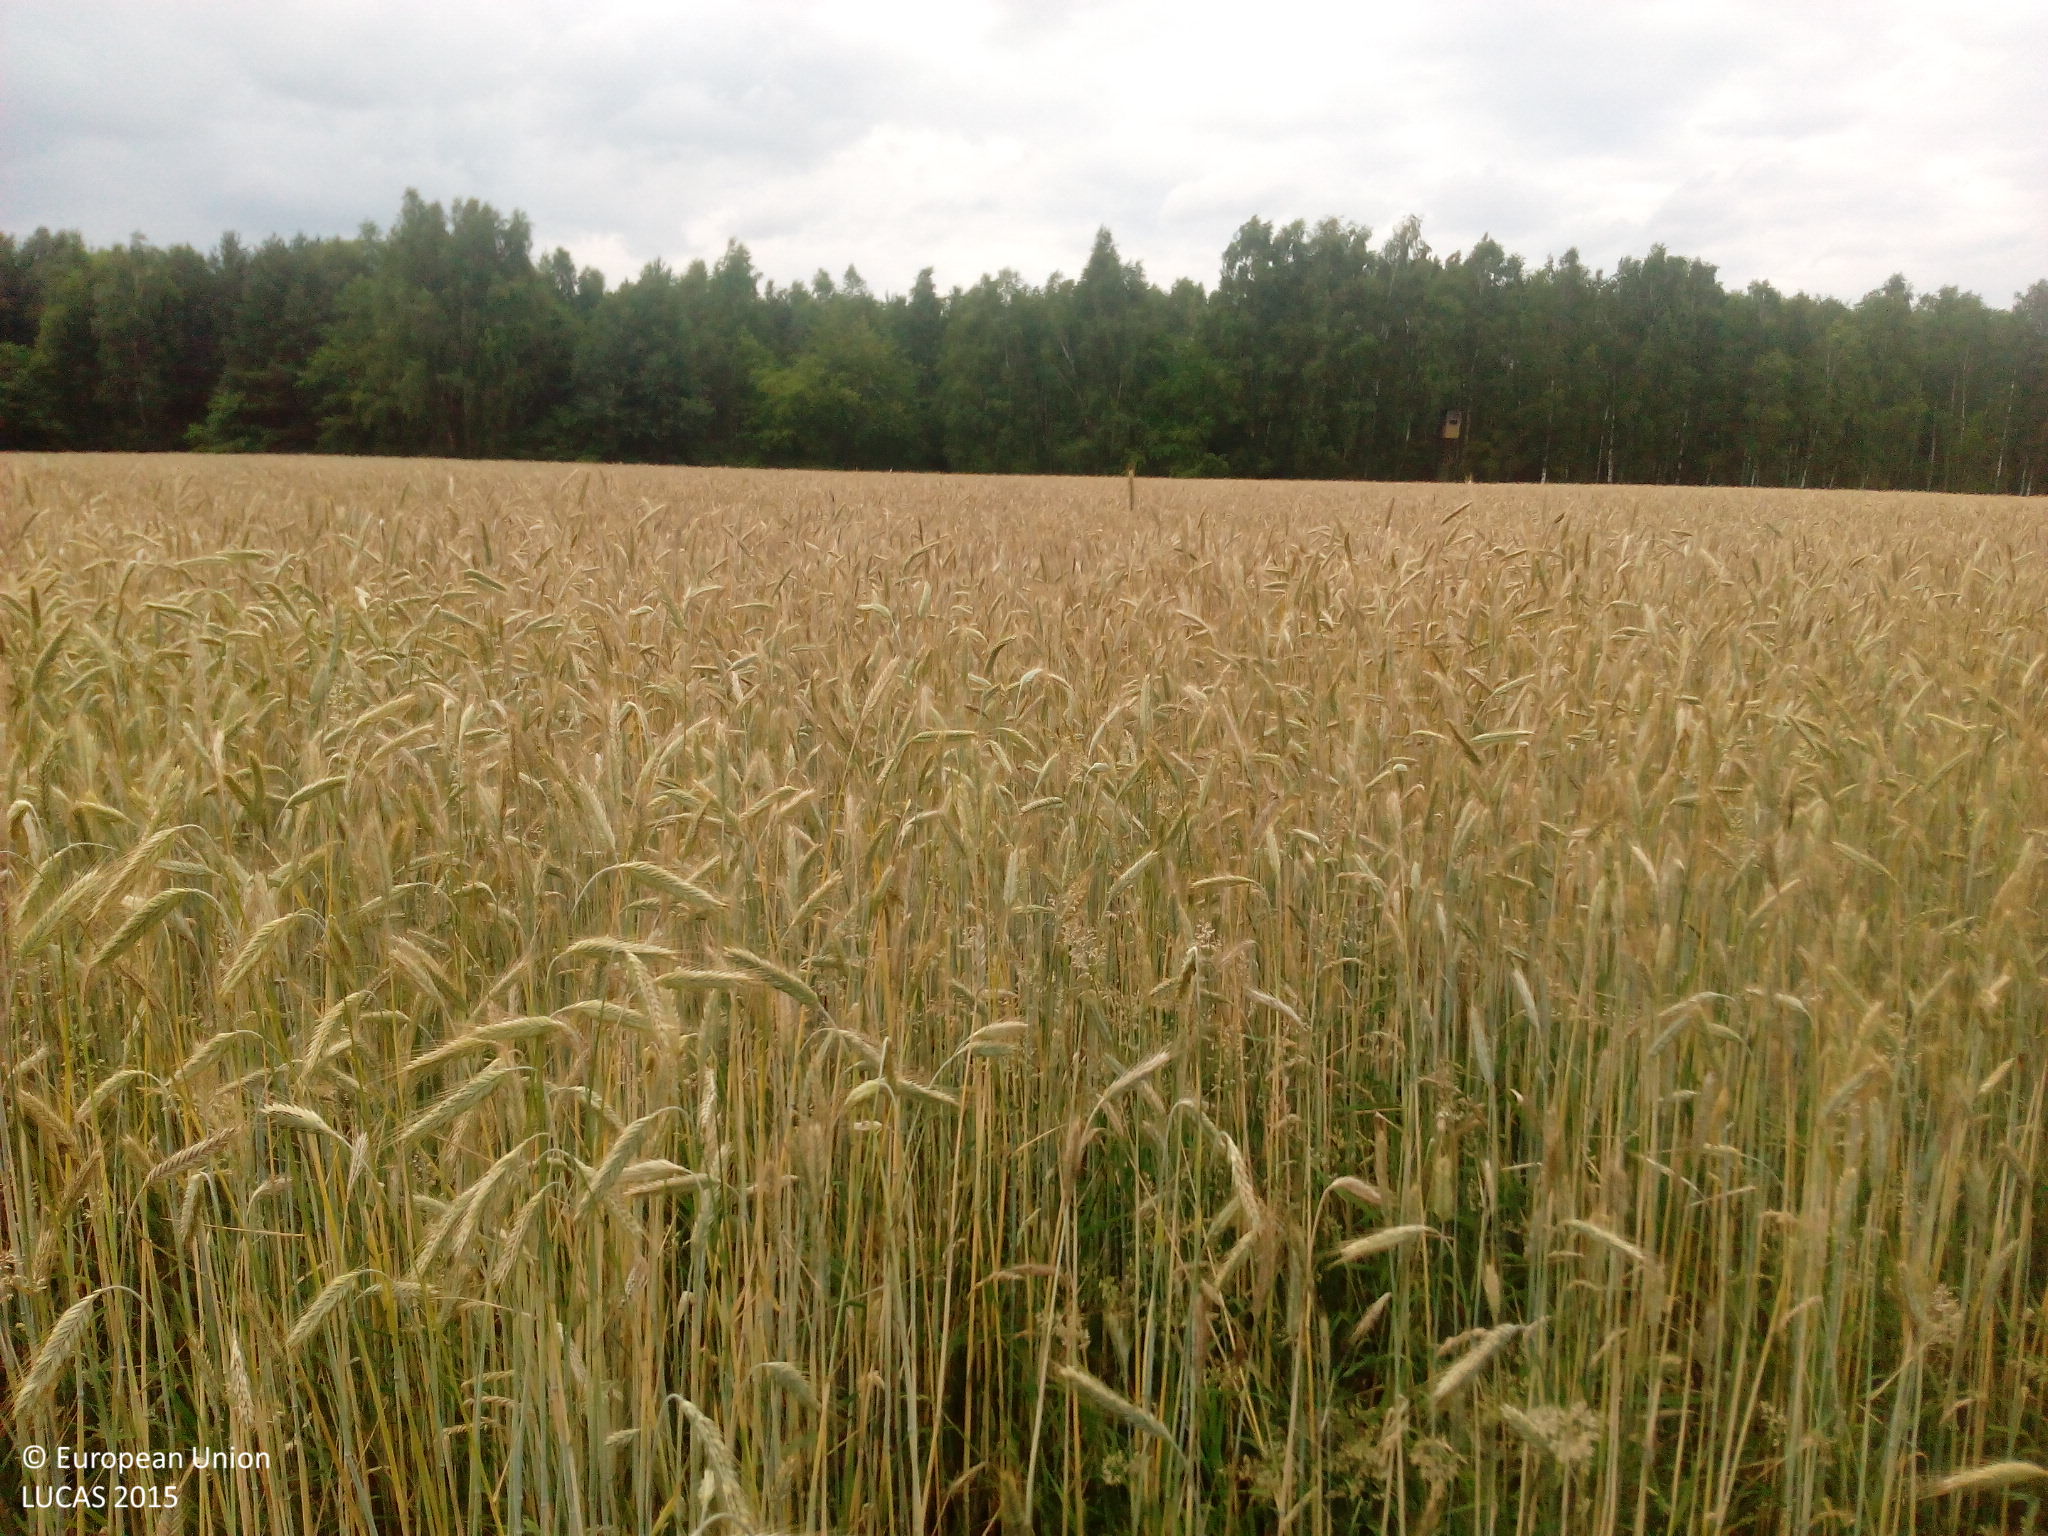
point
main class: Cropland
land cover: Rye
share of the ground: > 75 %
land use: Agriculture (excluding fallow land and kitchen gardens)
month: July
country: DE
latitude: 52.8922
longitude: 12.4222
